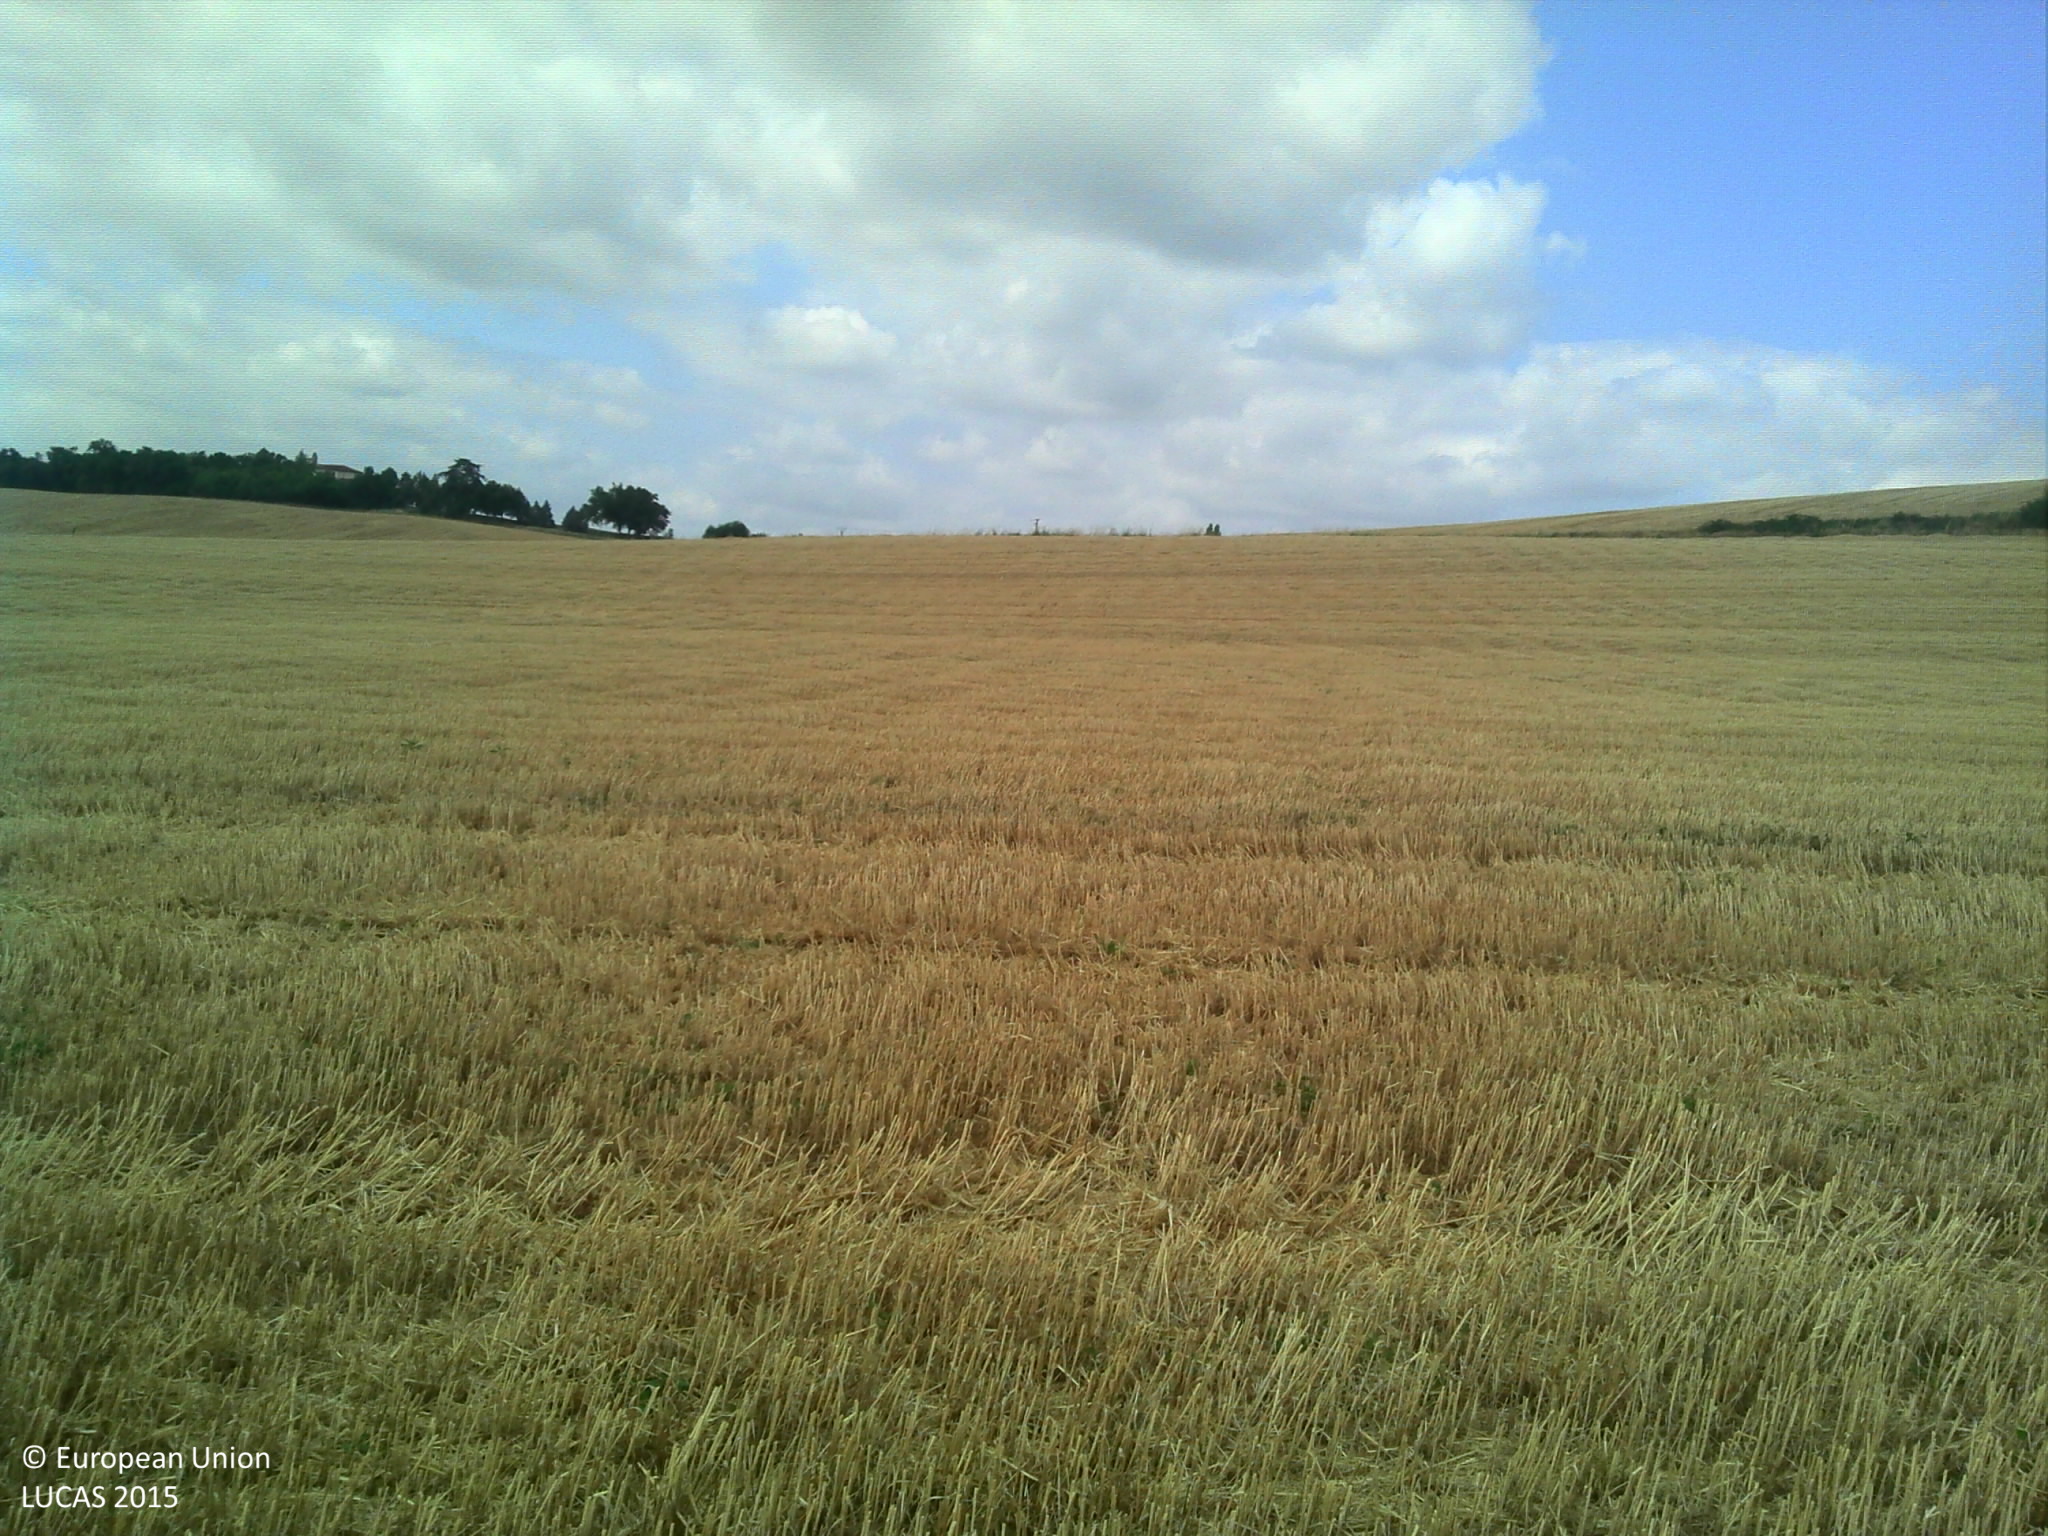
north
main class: Cropland
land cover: Barley
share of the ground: > 75 %
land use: Agriculture (excluding fallow land and kitchen gardens)
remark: Harvested field
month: July
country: FR
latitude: 43.8103
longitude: 0.9614
